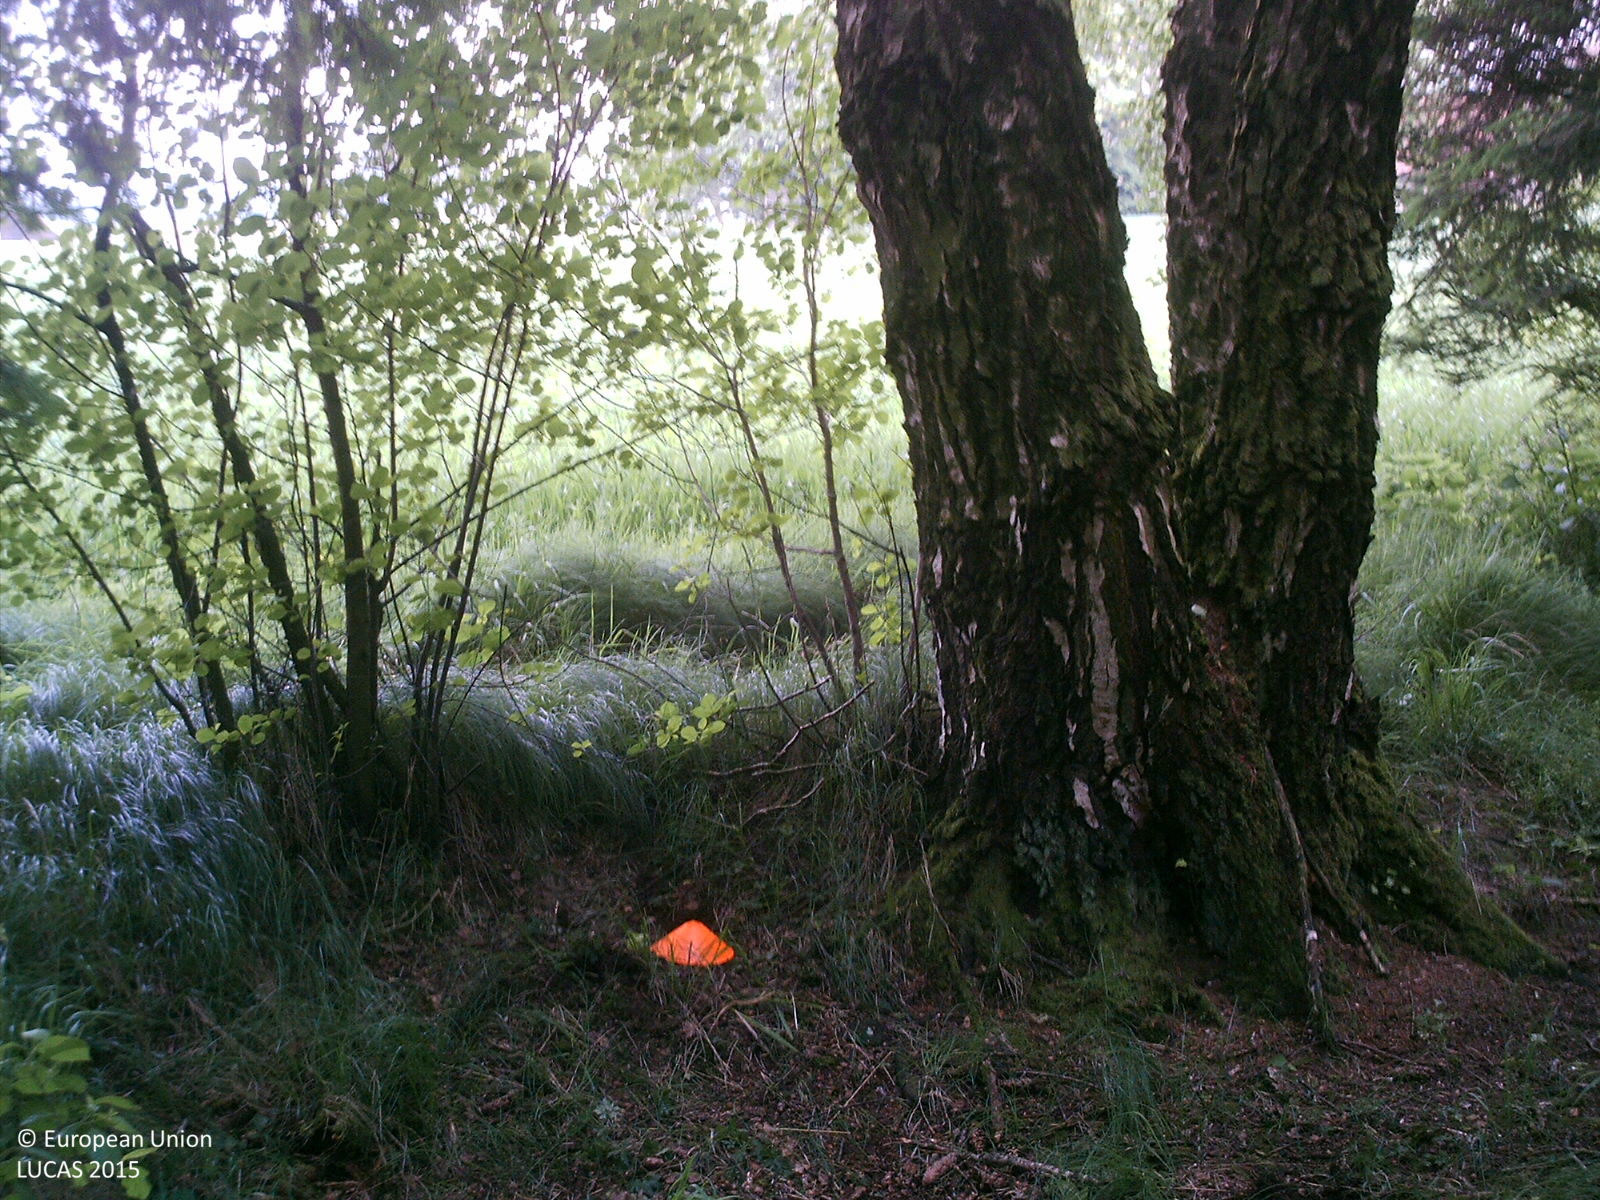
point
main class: Woodland
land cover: Spruce dominated mixed woodland
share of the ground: > 75 %
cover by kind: coniferous forest trees 75 %, broadleaved forest trees 25 %
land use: Forestry
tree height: > 5 m
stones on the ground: < 10 %
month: May
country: AT
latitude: 48.1114
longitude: 14.0963
